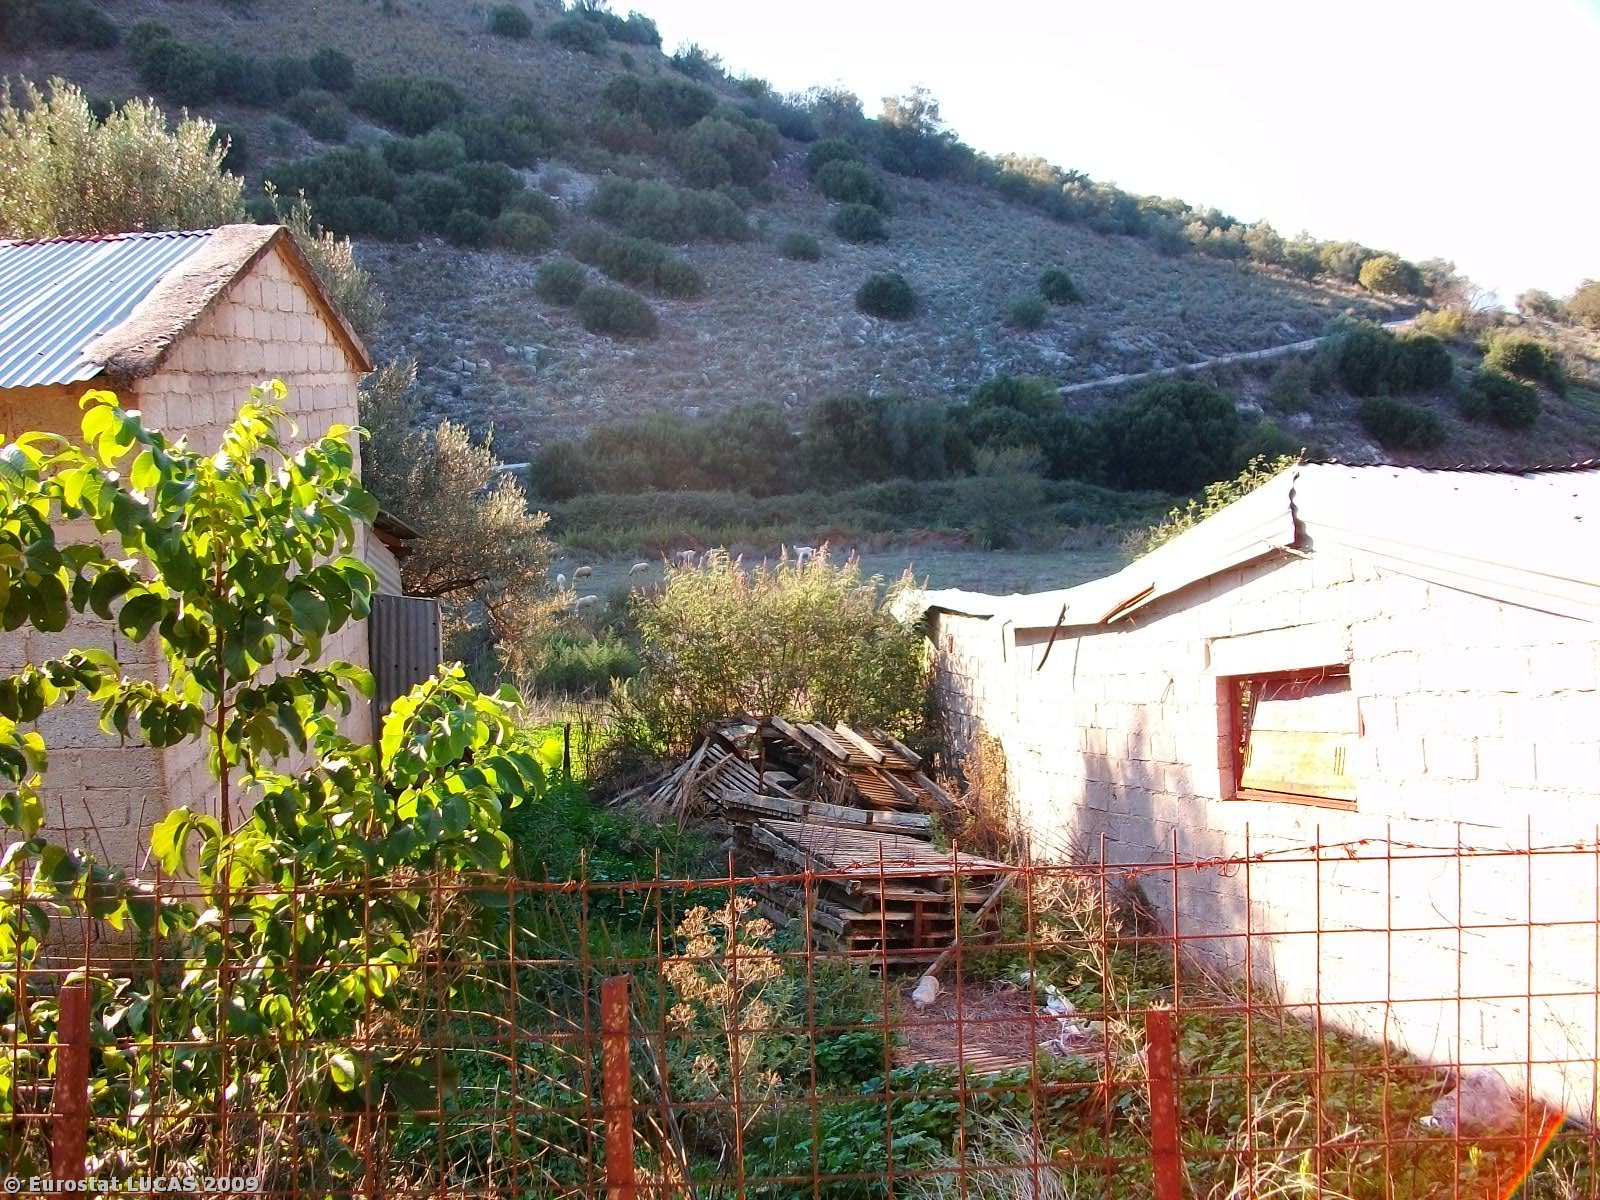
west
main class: Cropland
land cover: Nuts trees
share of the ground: 25 - 50 %
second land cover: Bare land
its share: > 75 %
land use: Kitchen garden
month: October
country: GR
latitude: 39.3942
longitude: 20.4820
